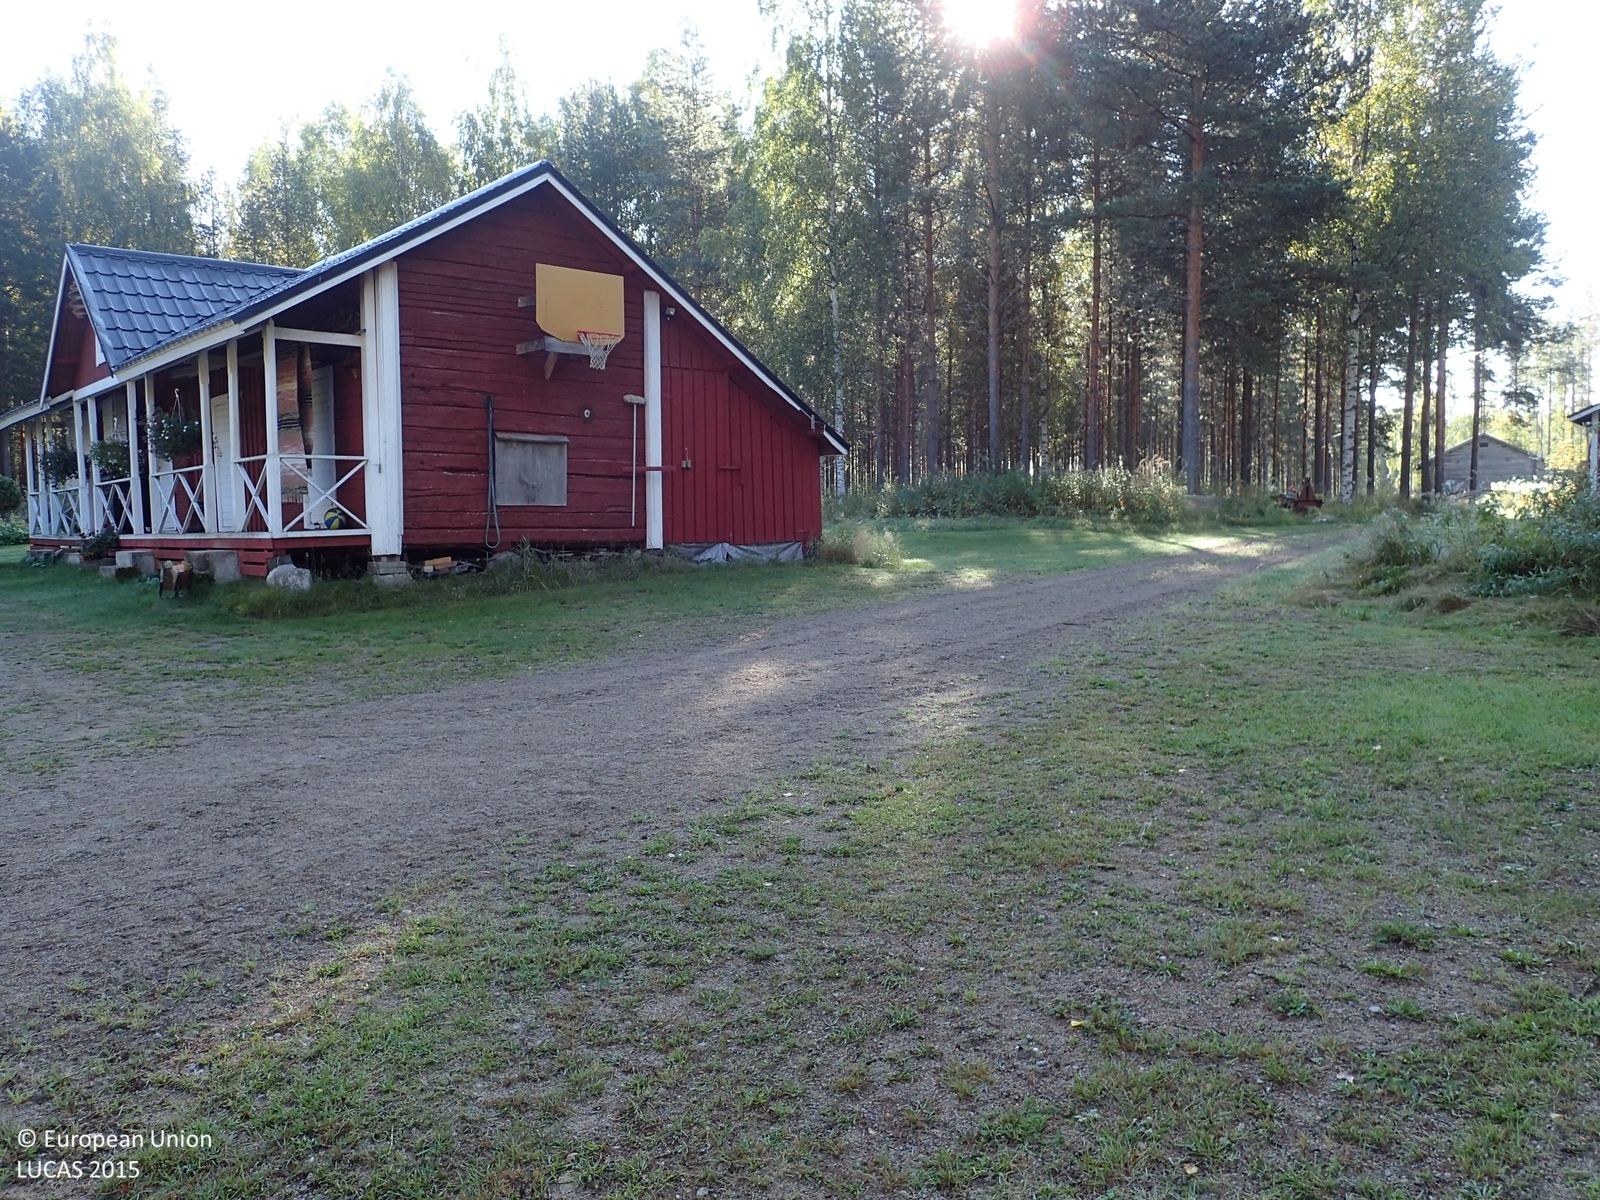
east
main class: Grassland
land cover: Grassland without tree/shrub cover
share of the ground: > 75 %
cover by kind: herbaceous plants 90 %, consolidated bare surface 10 %
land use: Residential
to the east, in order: Grassland without tree/shrub cover; Artificial constructions in urban areas; Grassland without tree/shrub cover; Broadleaved woodland; Ditches and canals; Tracks; Ditches and canals; Pine dominated mixed woodland; Ditches and canals; Pine dominated mixed woodland; Ditches and canals; Pine dominated mixed woodland; Ditches and canals; Pine dominated mixed woodland; Ditches and canals; Broadleaved woodland
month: September
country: FI
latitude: 62.9174
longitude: 25.2417
